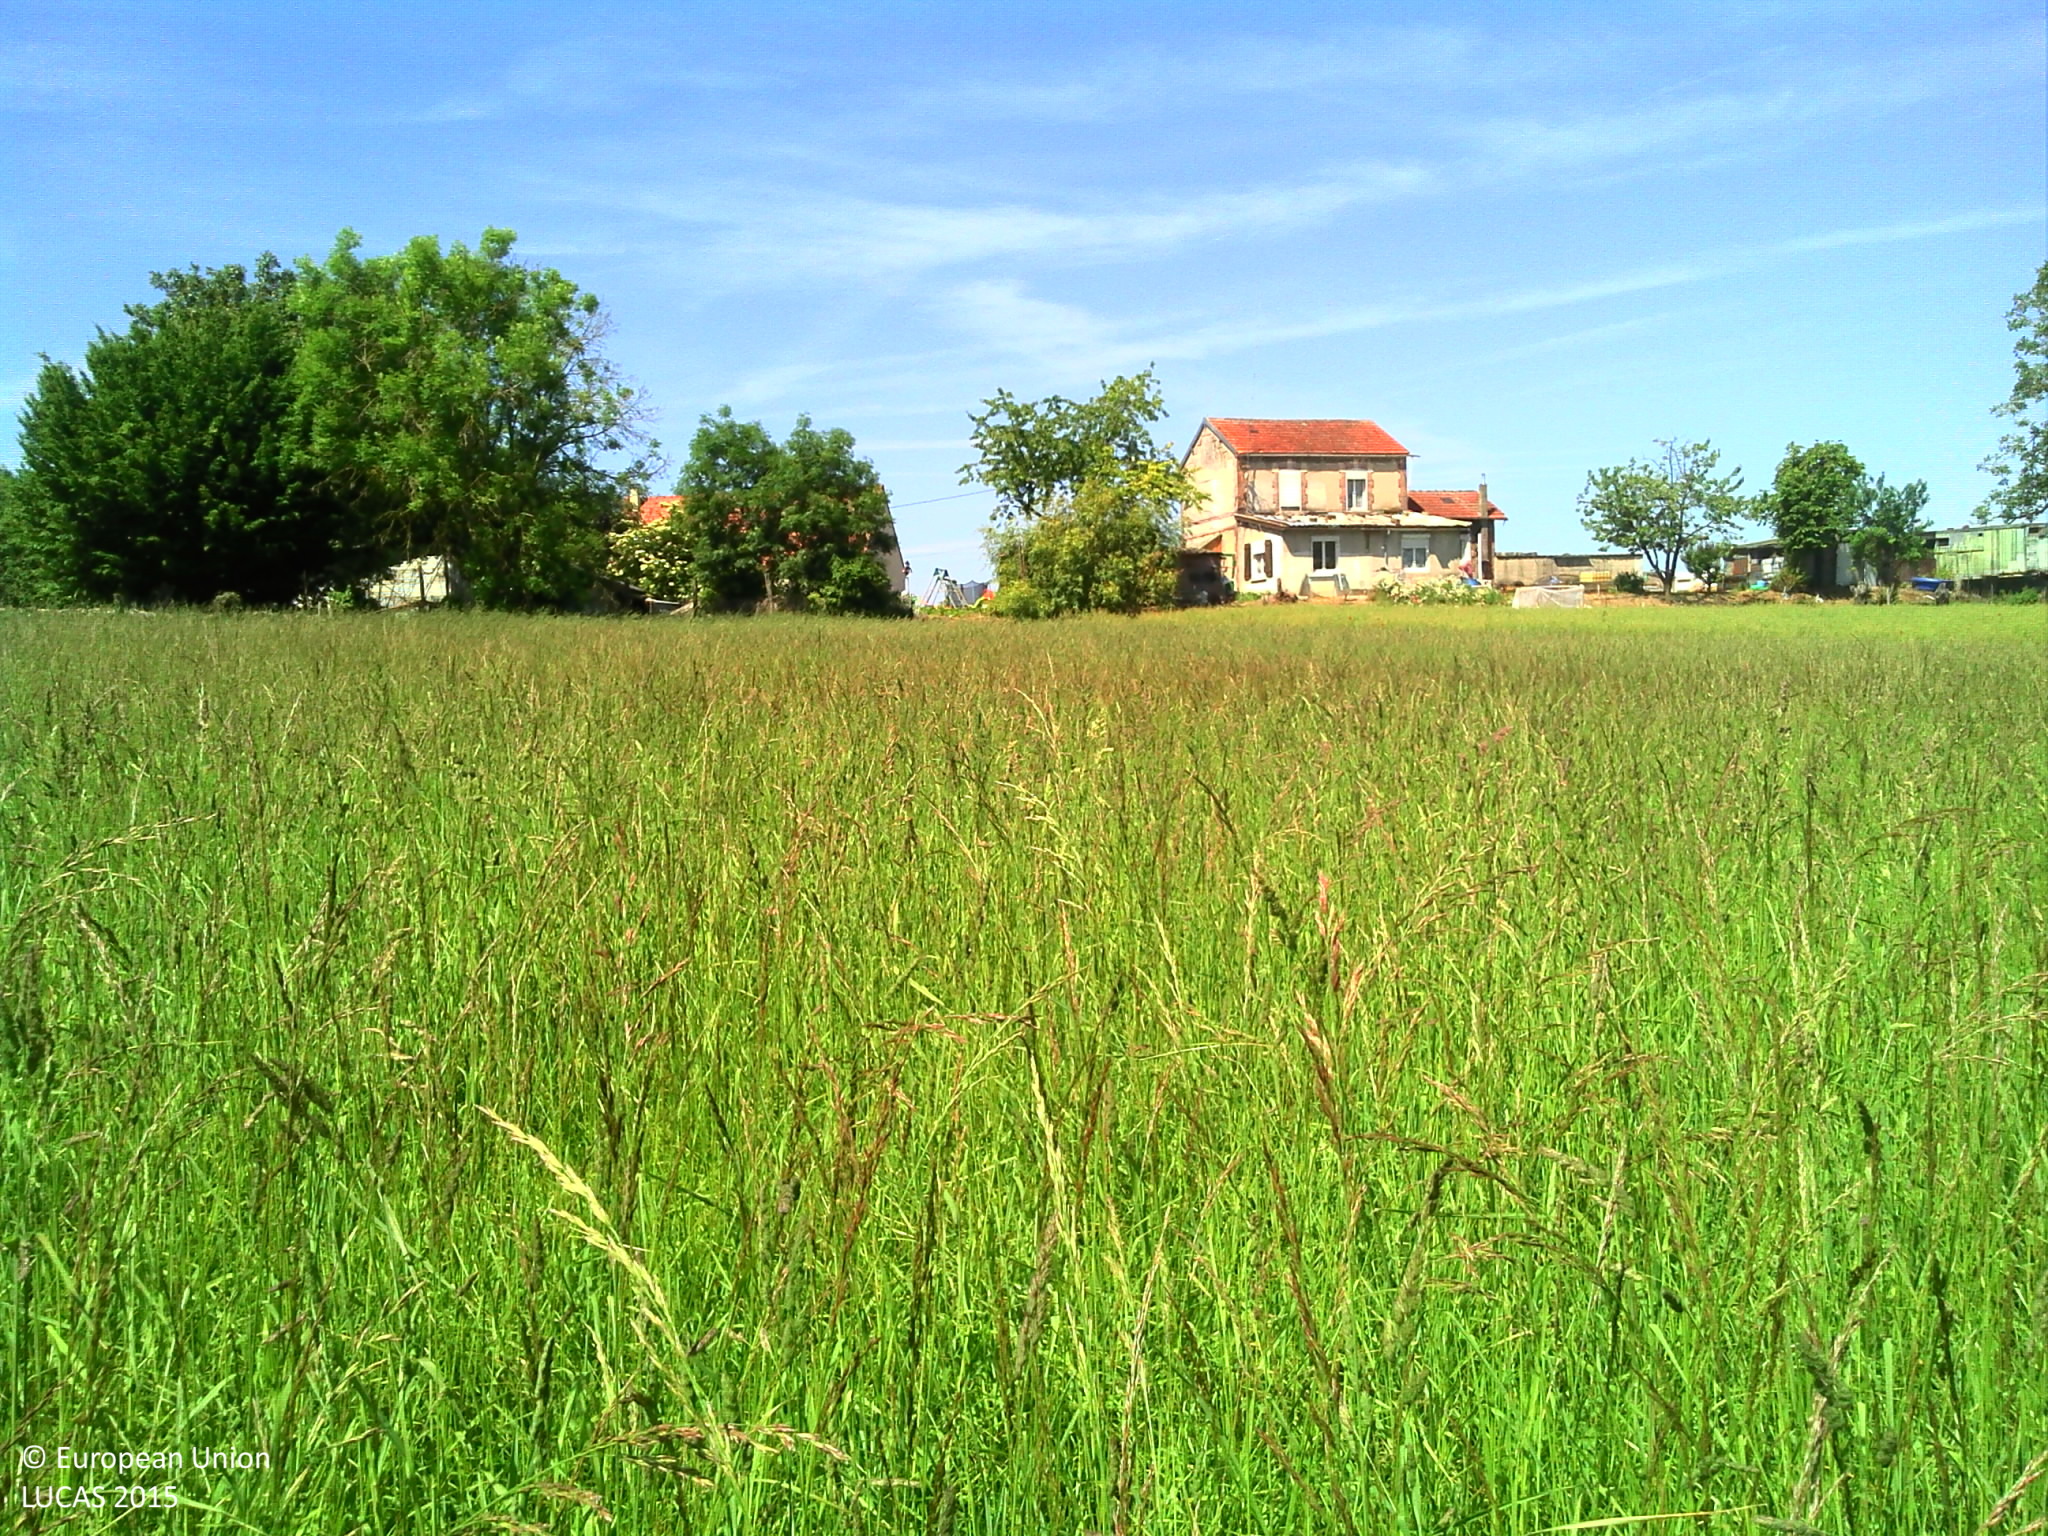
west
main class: Cropland
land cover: Temporary grasslands
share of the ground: > 75 %
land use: Agriculture (excluding fallow land and kitchen gardens)
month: June
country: FR
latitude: 49.4280
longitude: 3.3050
